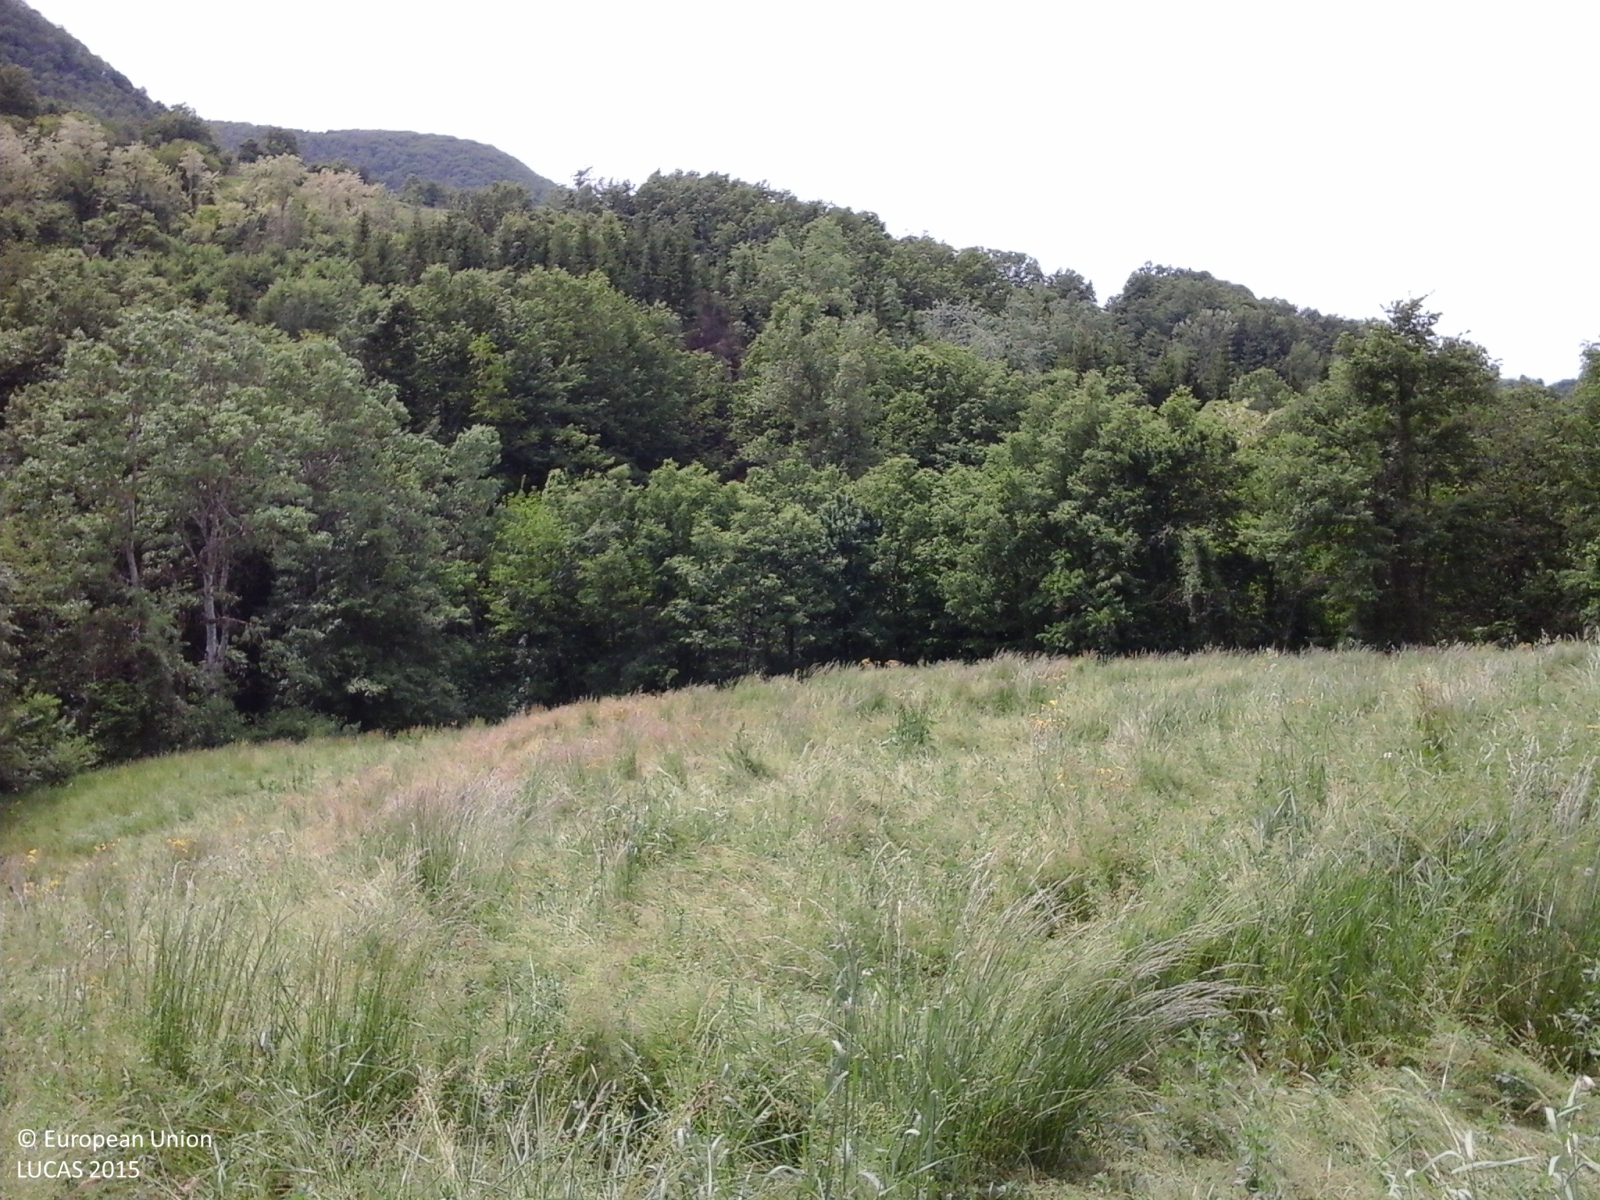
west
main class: Woodland
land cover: Broadleaved woodland
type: thermophilous deciduous forest
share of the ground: > 75 %
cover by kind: broadleaved forest trees 100 %
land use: Forestry
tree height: > 5 m
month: May
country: IT
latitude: 44.3476
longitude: 10.7885
